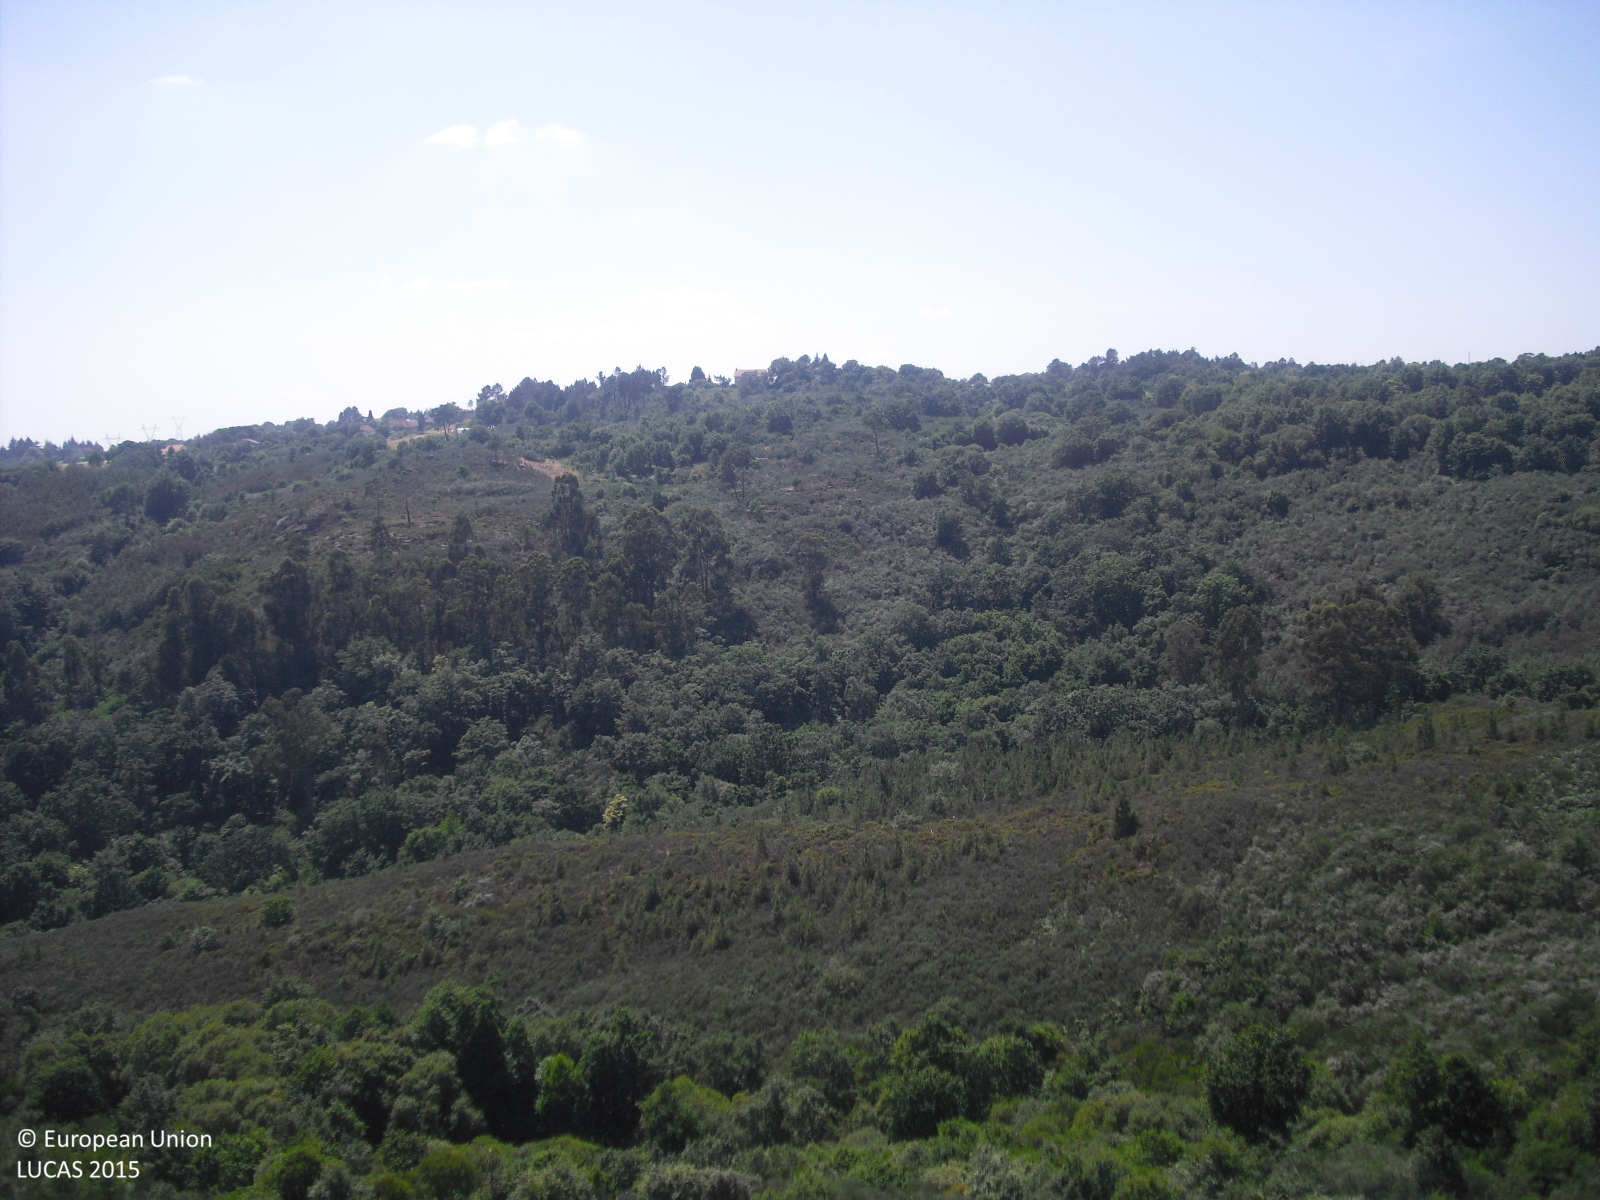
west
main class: Shrubland
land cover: Shrubland with sparse tree cover
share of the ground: > 75 %
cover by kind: shrubs 95 %, broadleaved forest trees 5 %
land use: Semi-natural and natural areas not in use
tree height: < 5 m
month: June
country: ES
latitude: 42.3780
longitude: -7.8701
